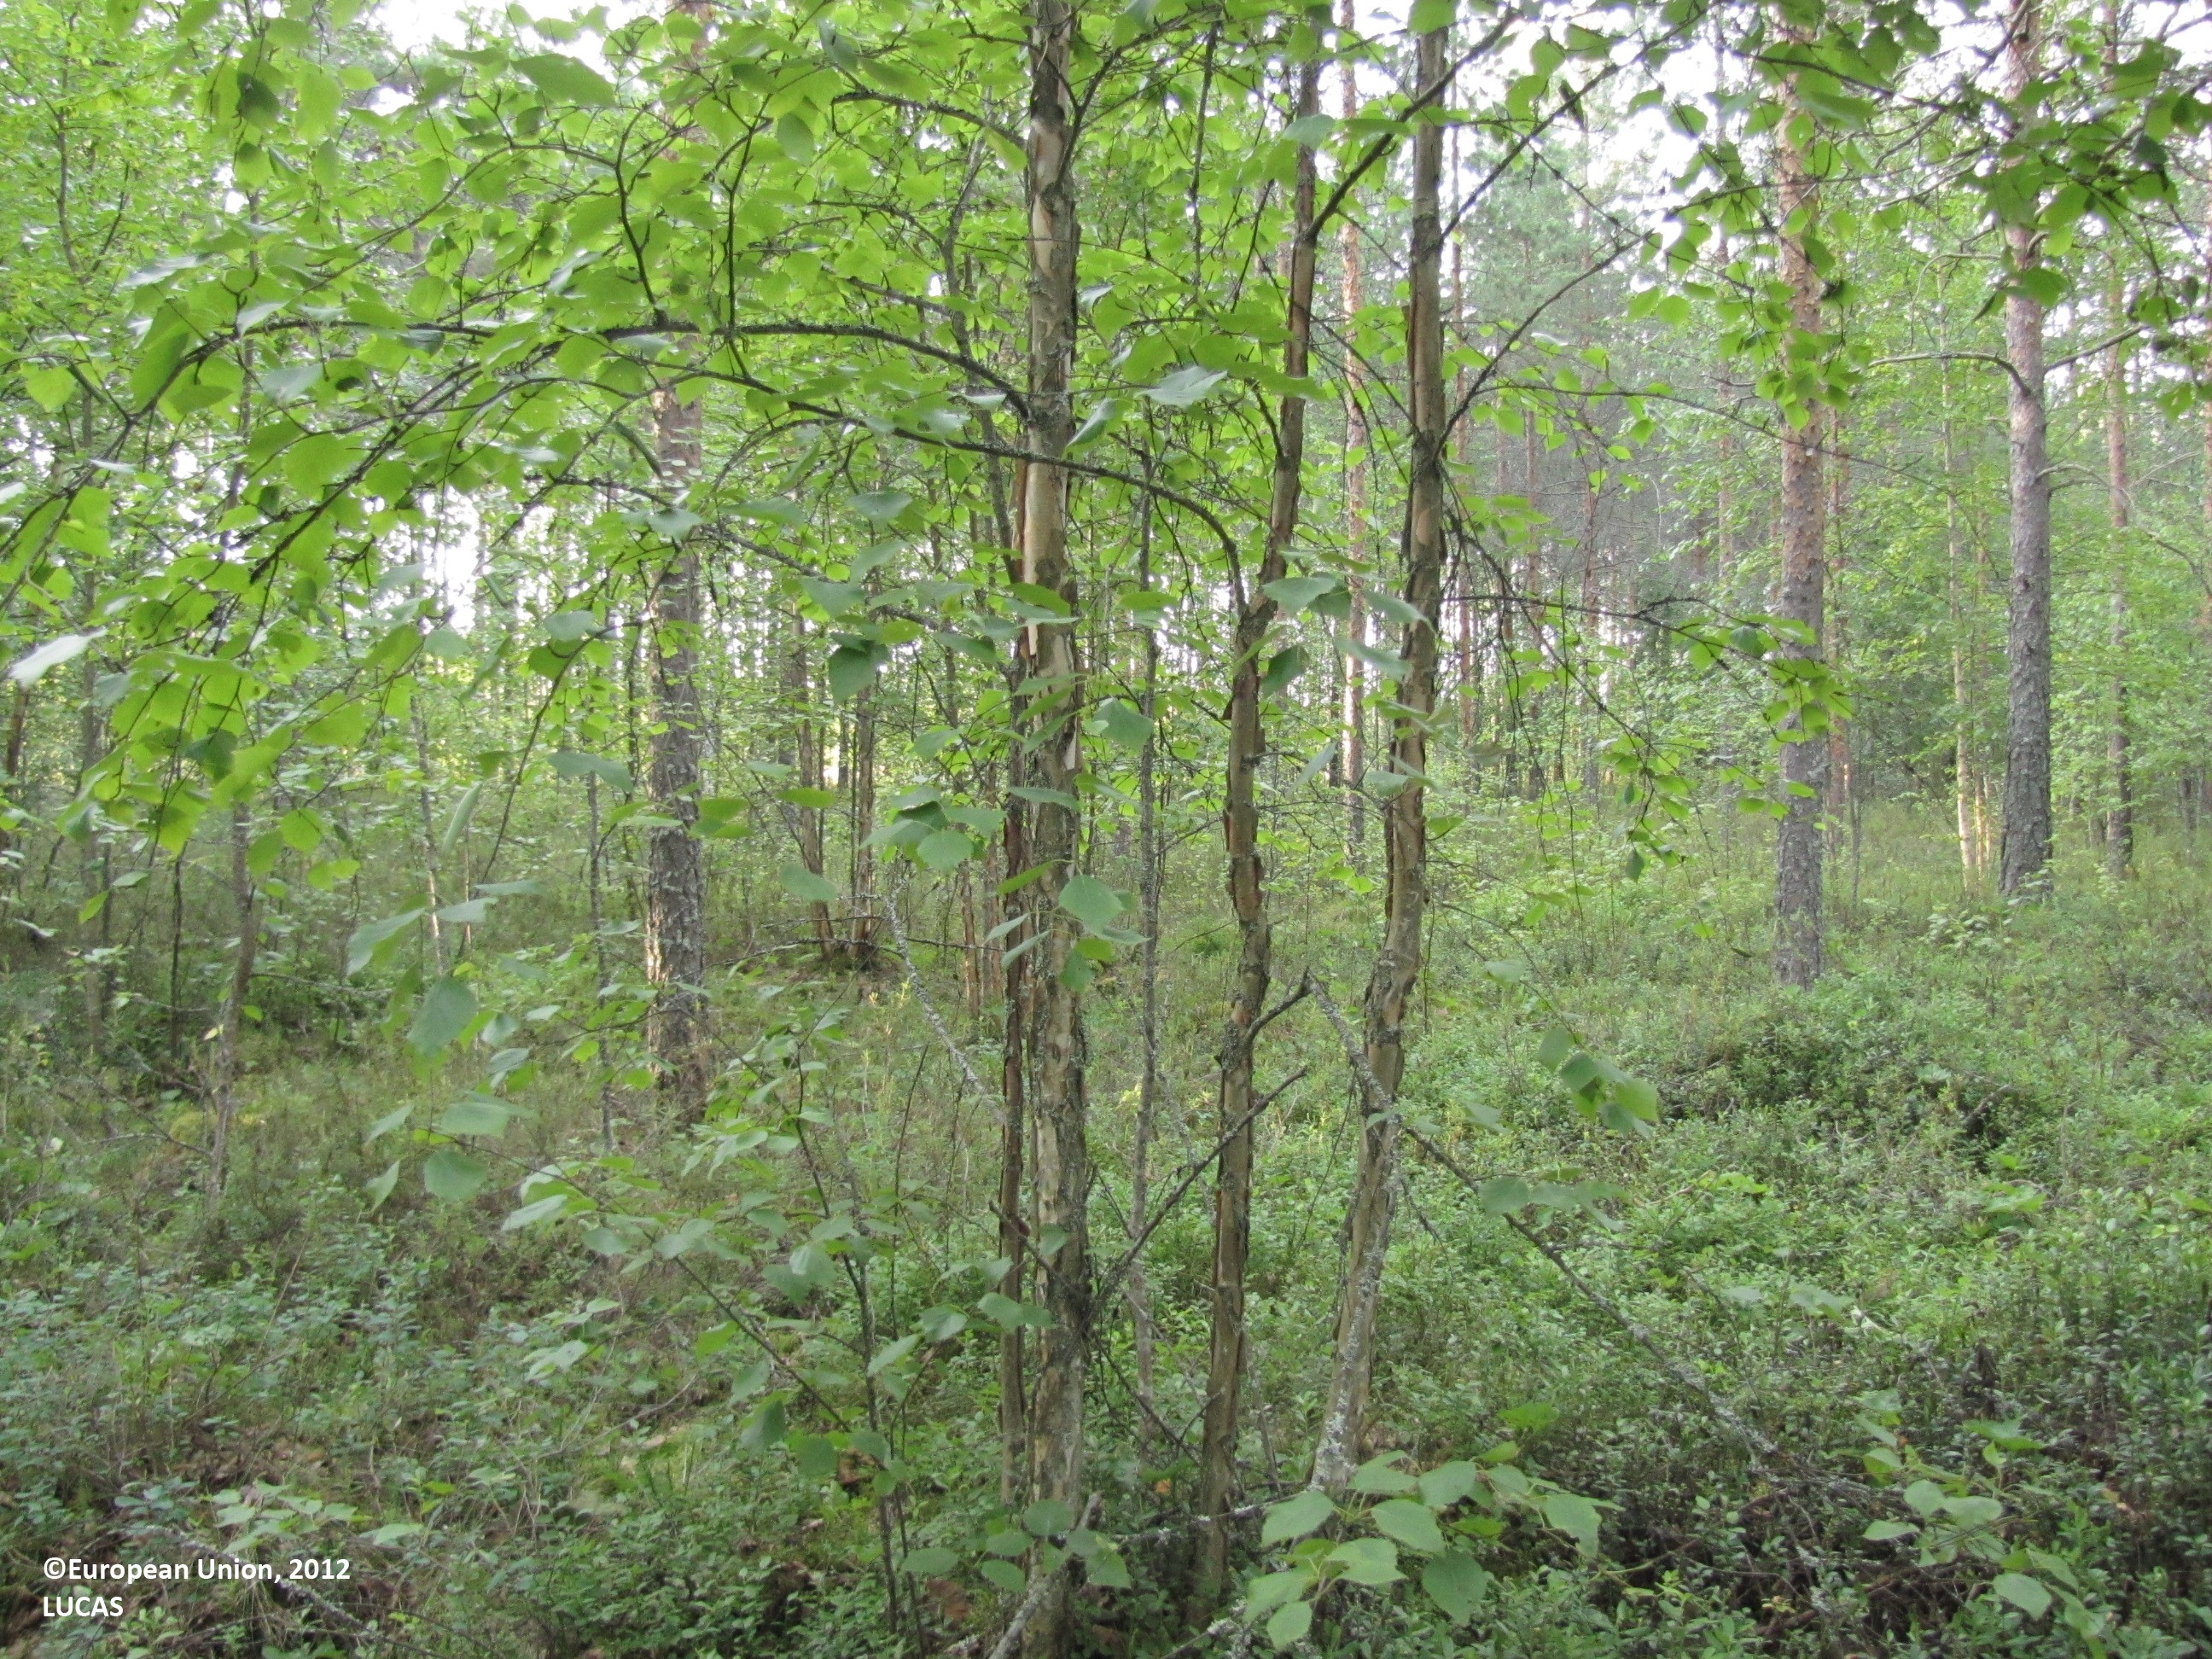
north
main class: Woodland
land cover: Pine dominated mixed woodland
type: mire and swamp forests
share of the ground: > 75 %
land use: Forestry
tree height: > 5 m
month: July
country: FI
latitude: 62.5925
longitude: 23.4473
